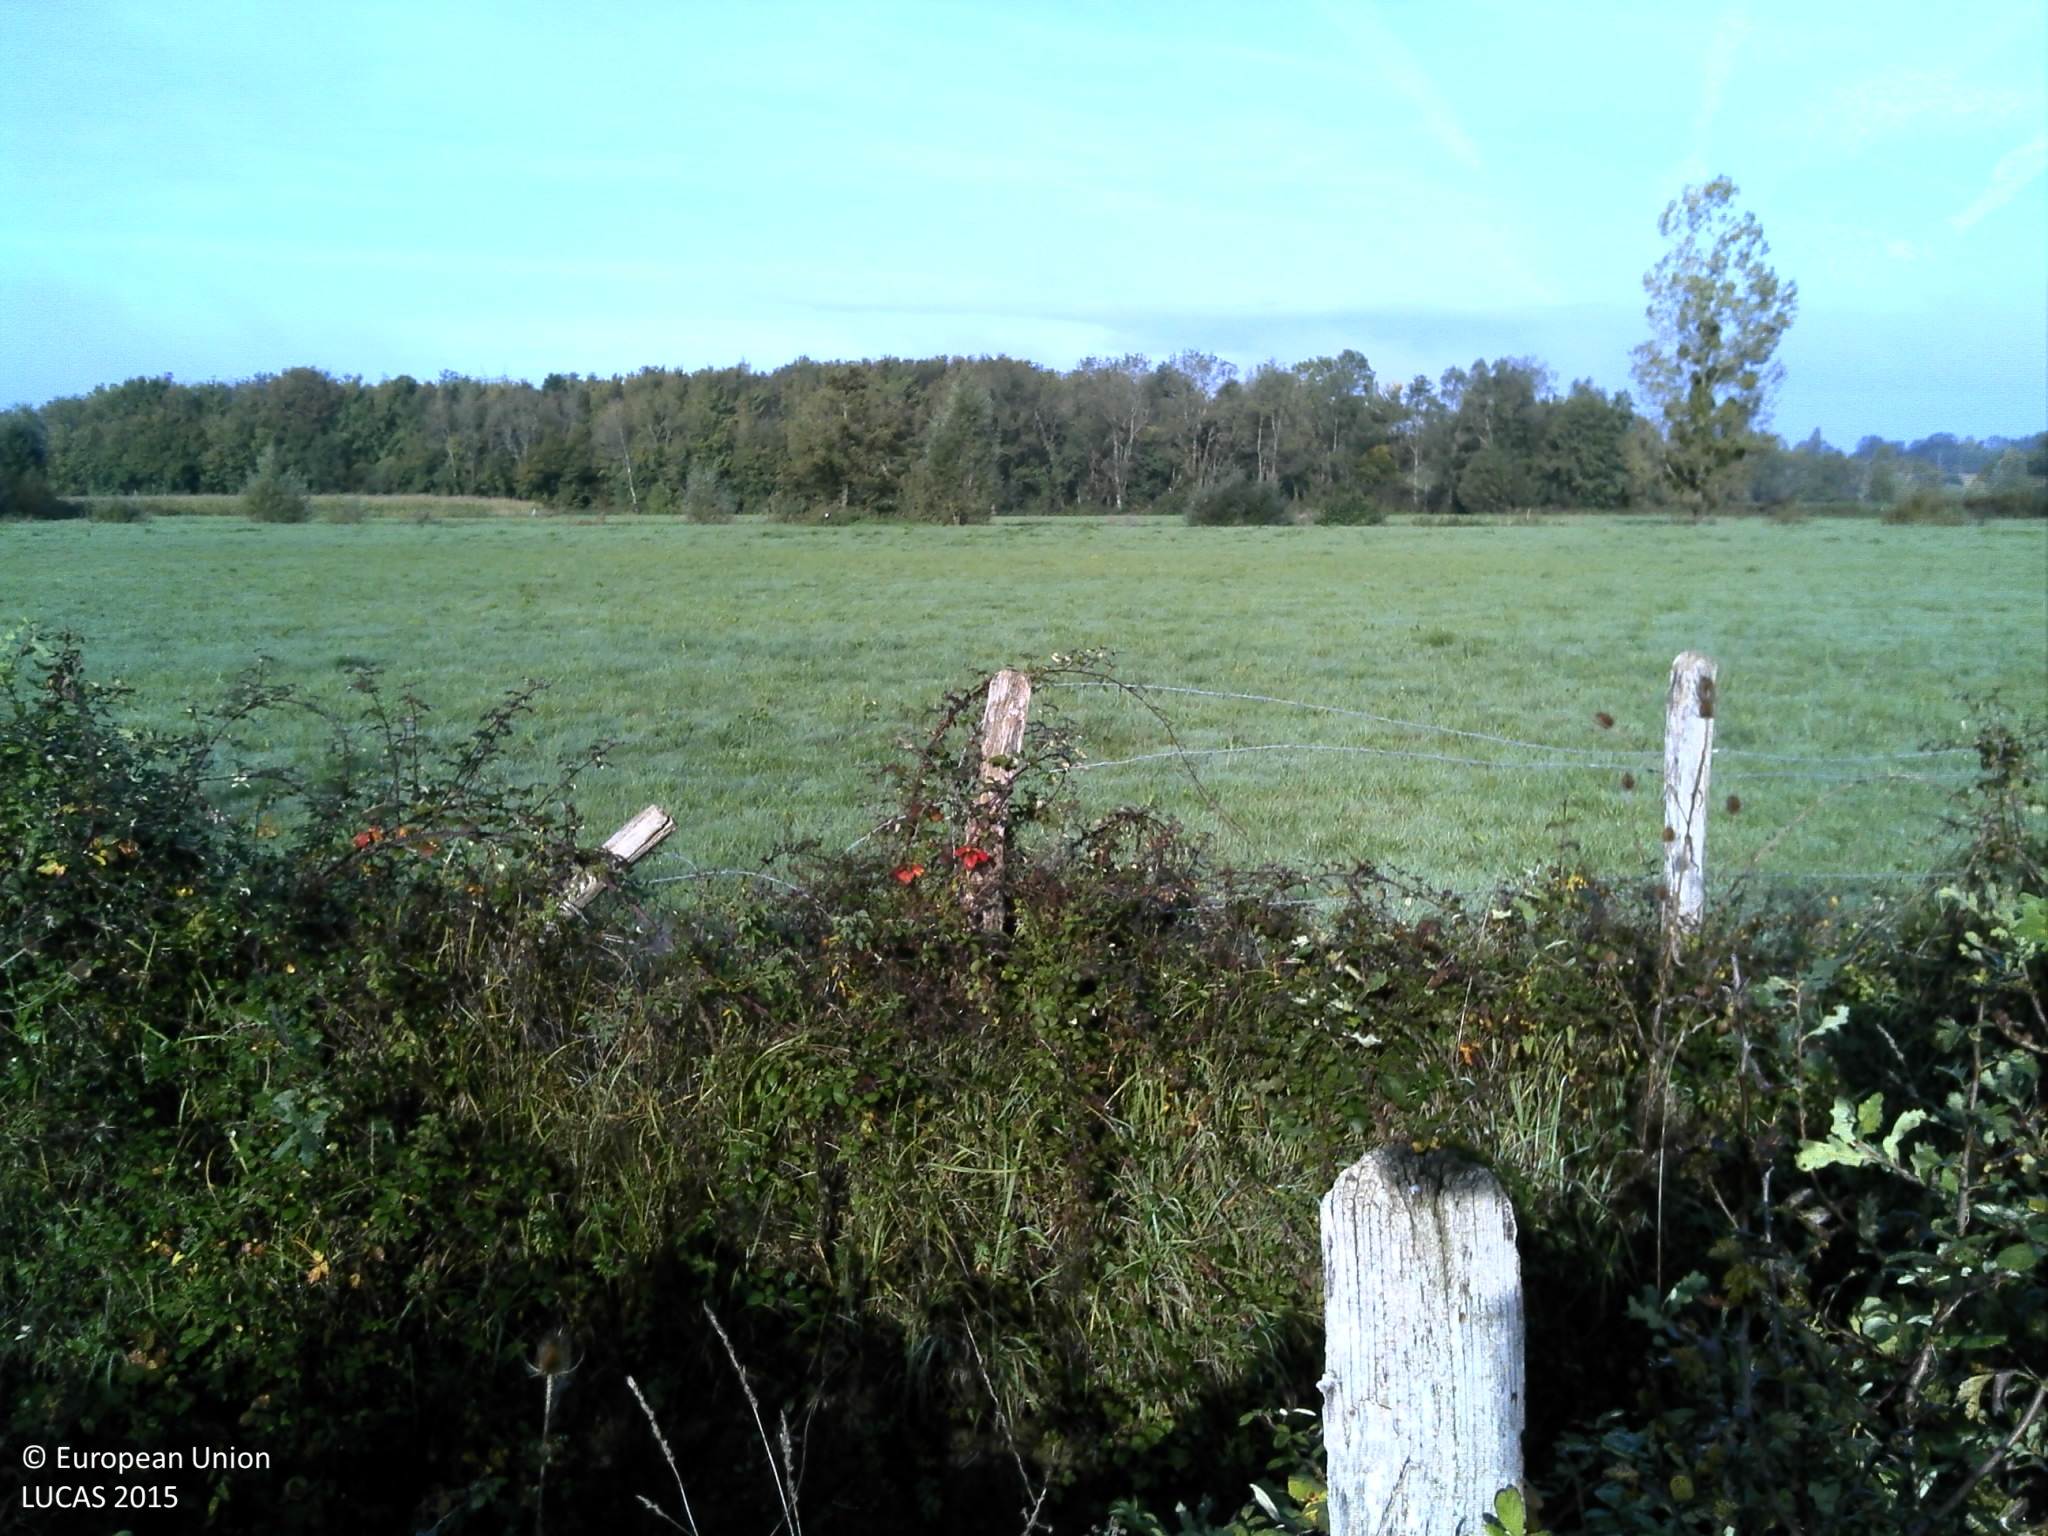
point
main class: Grassland
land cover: Grassland without tree/shrub cover
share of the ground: > 75 %
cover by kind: herbaceous plants 100 %
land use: Agriculture (excluding fallow land and kitchen gardens)
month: October
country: FR
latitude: 46.5926
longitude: 5.3426
